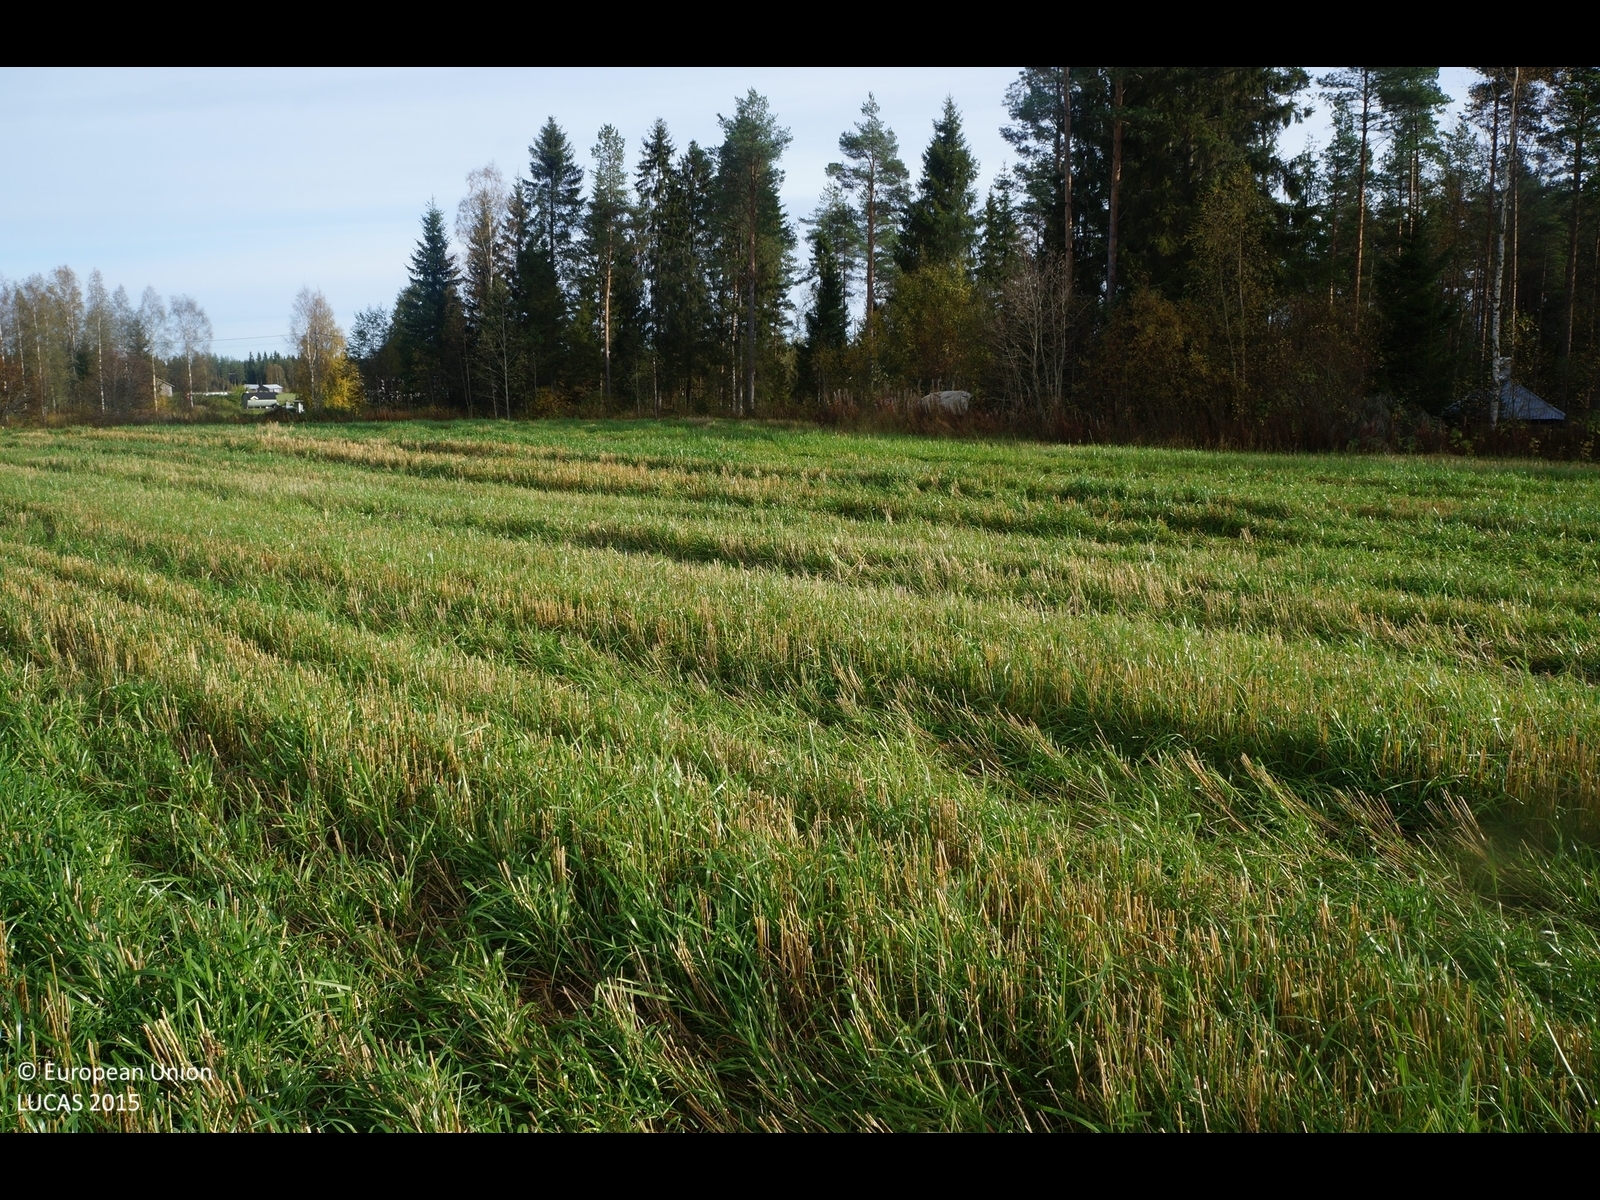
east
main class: Cropland
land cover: Temporary grasslands
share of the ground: > 75 %
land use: Agriculture (excluding fallow land and kitchen gardens)
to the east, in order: Temporary grasslands; Ditches and canals; Spruce dominated mixed woodland; Other mixed woodland; Inland fresh running water; Artificial constructions in urban areas; Paved roads, cycling and walking lanes
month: September
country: FI
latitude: 63.8755
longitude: 24.0932
